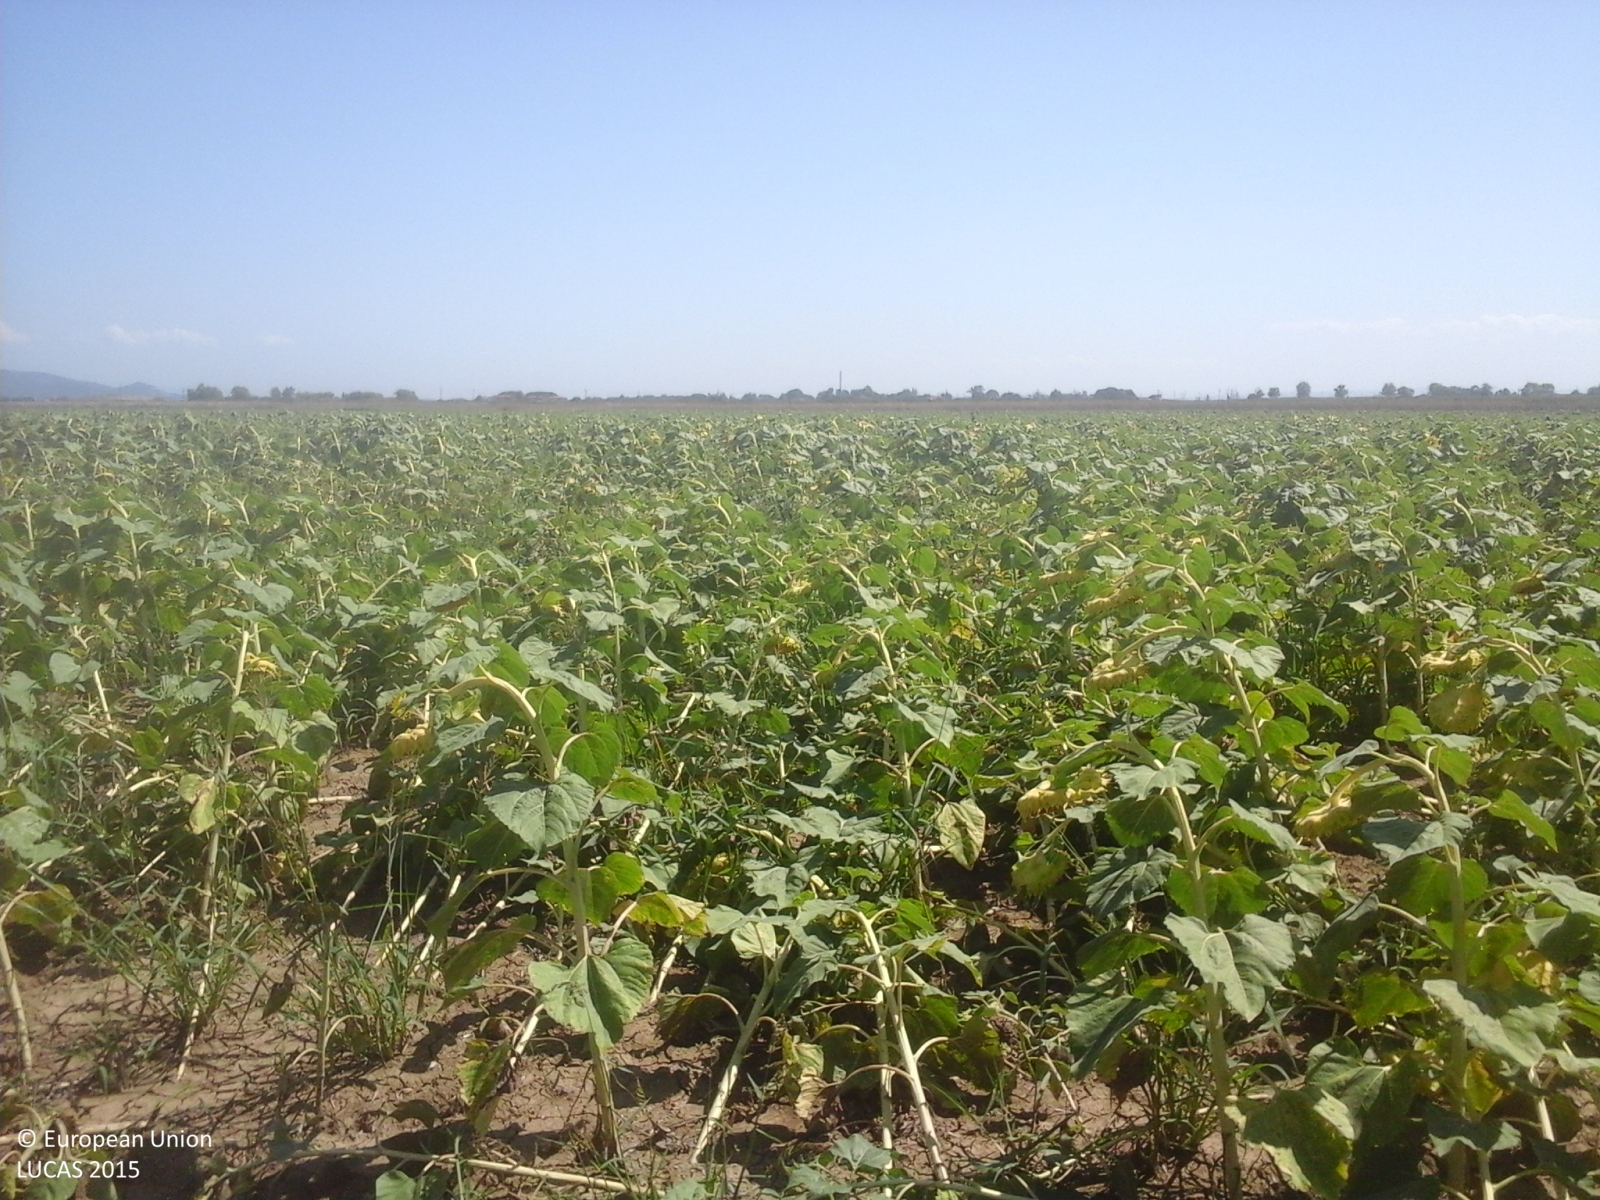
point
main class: Cropland
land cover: Sunflower
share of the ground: > 75 %
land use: Agriculture (excluding fallow land and kitchen gardens)
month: August
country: IT
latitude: 43.6460
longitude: 10.4327
